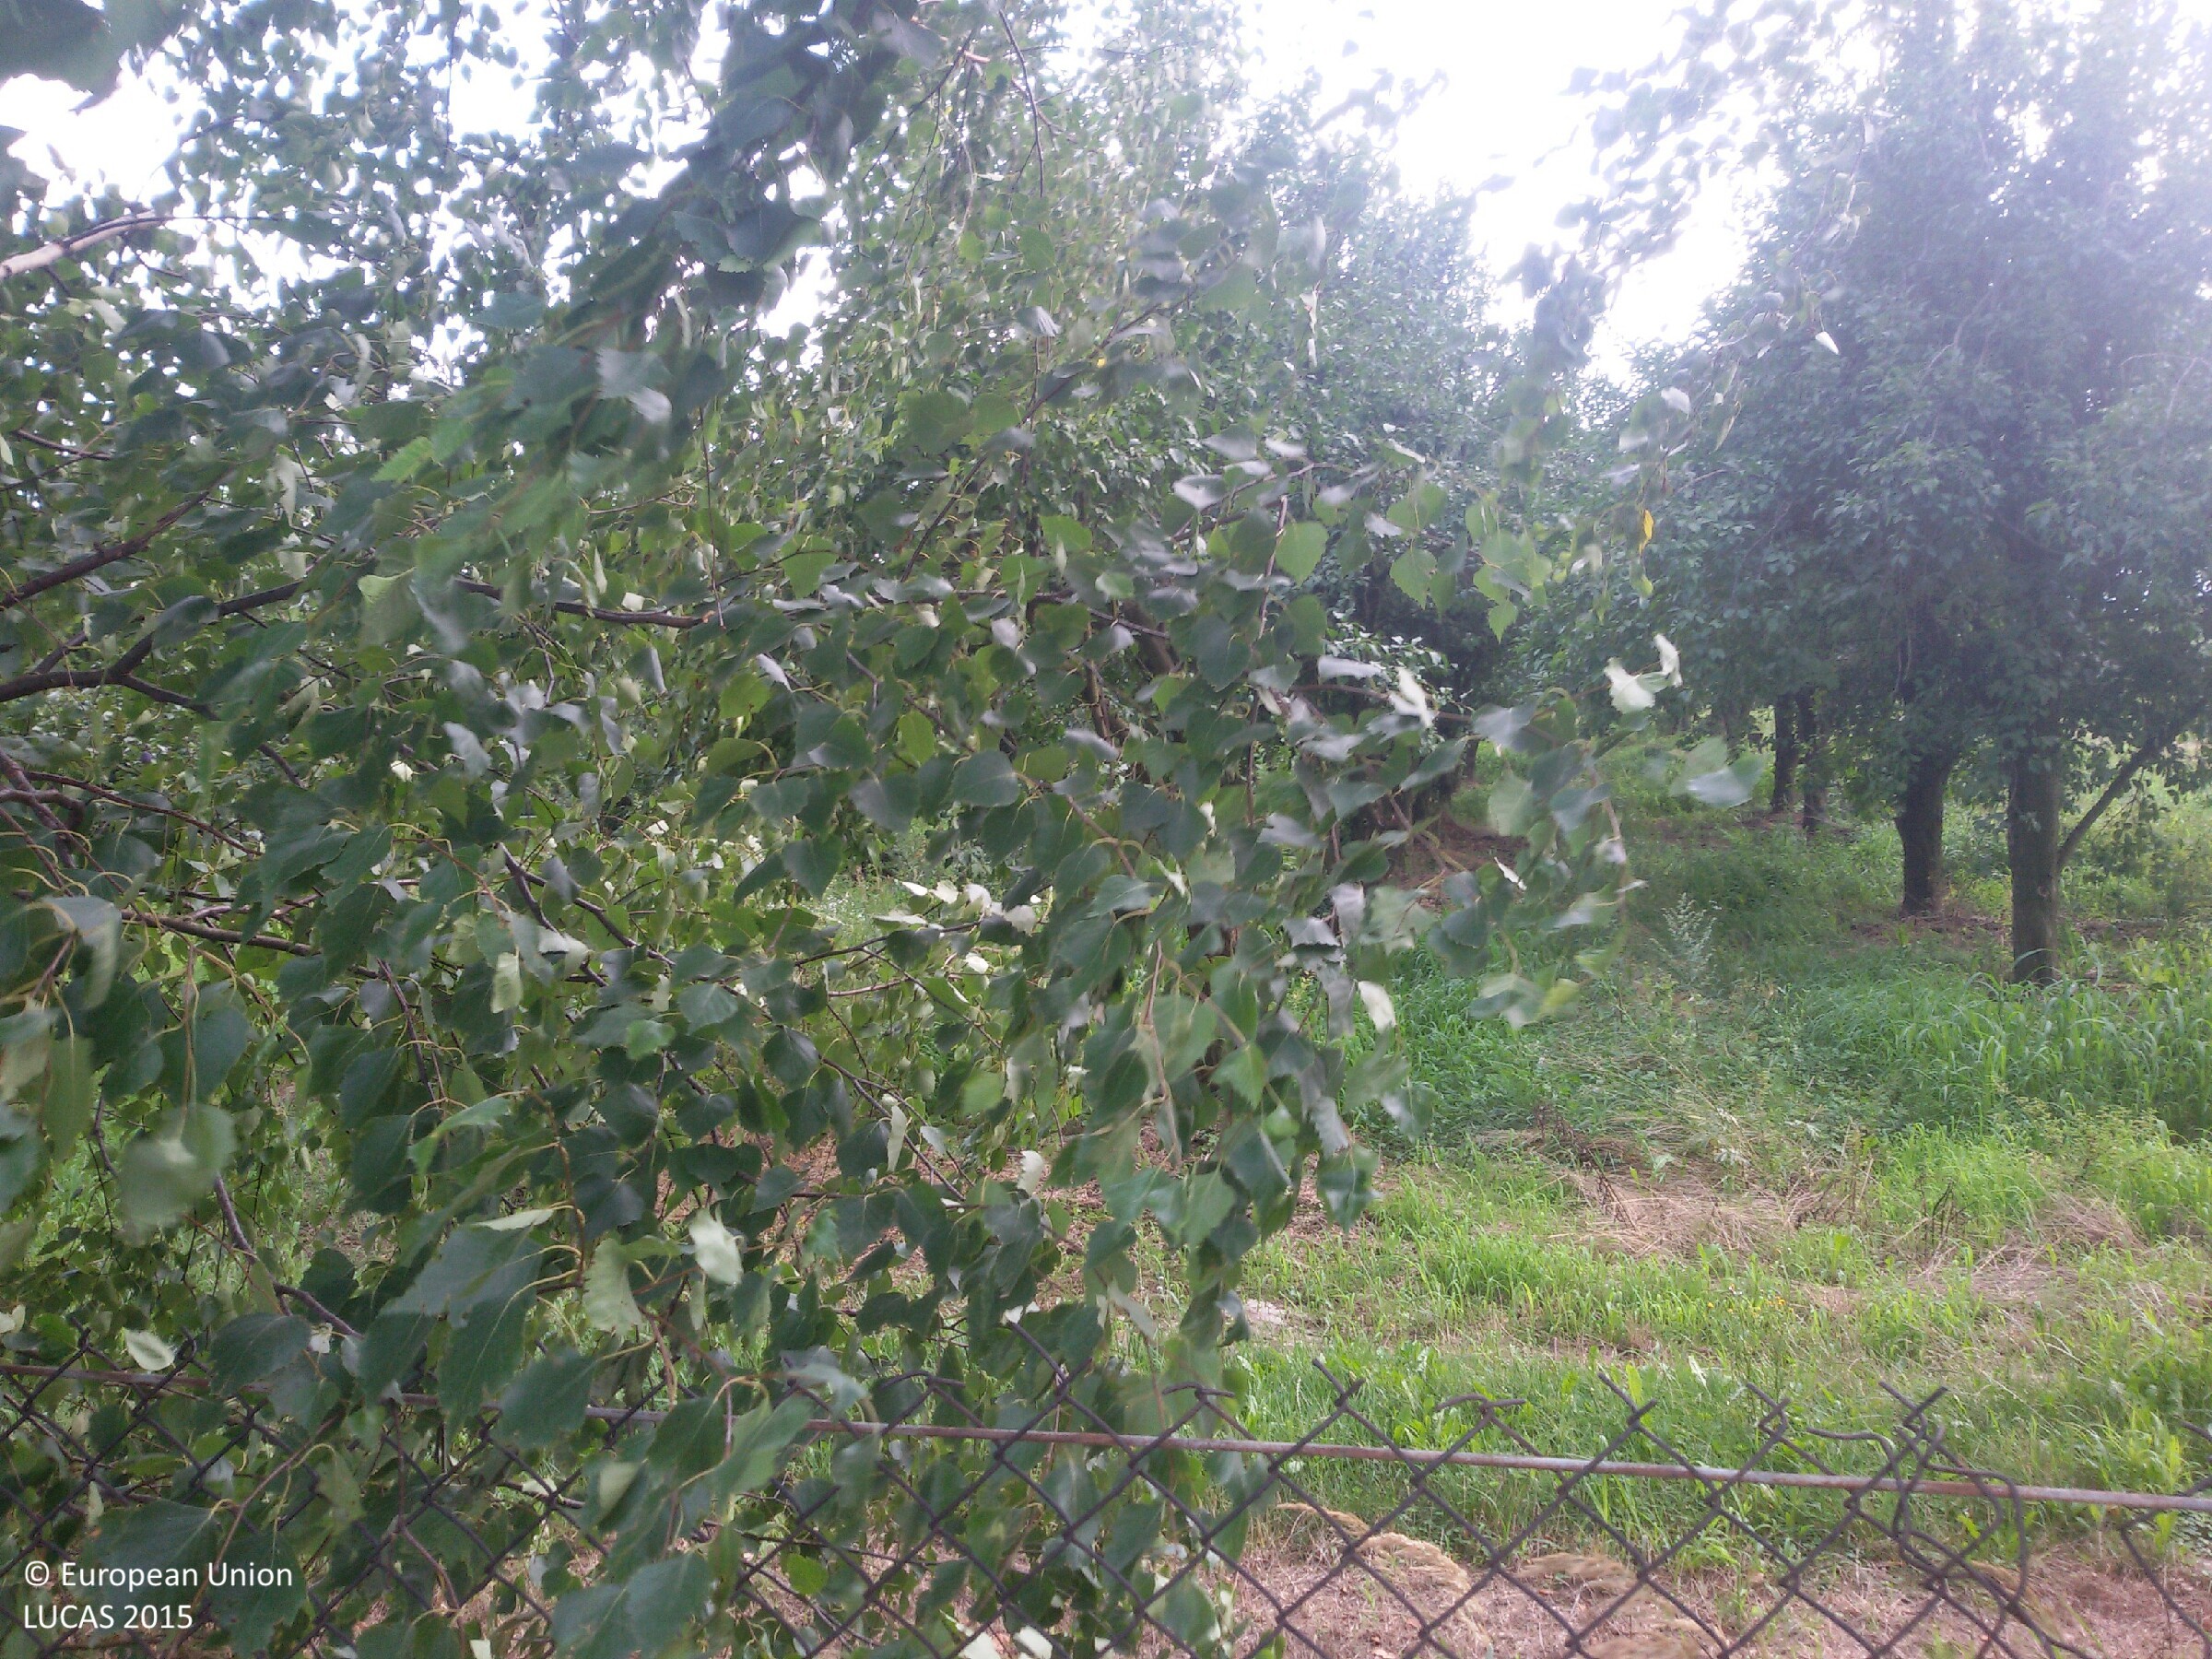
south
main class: Cropland
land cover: Other fruit trees and berries
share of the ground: > 75 %
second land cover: Grassland without tree/shrub cover
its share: > 75 %
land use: Agriculture (excluding fallow land and kitchen gardens)
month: July
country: PL
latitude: 50.7083
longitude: 21.6795
